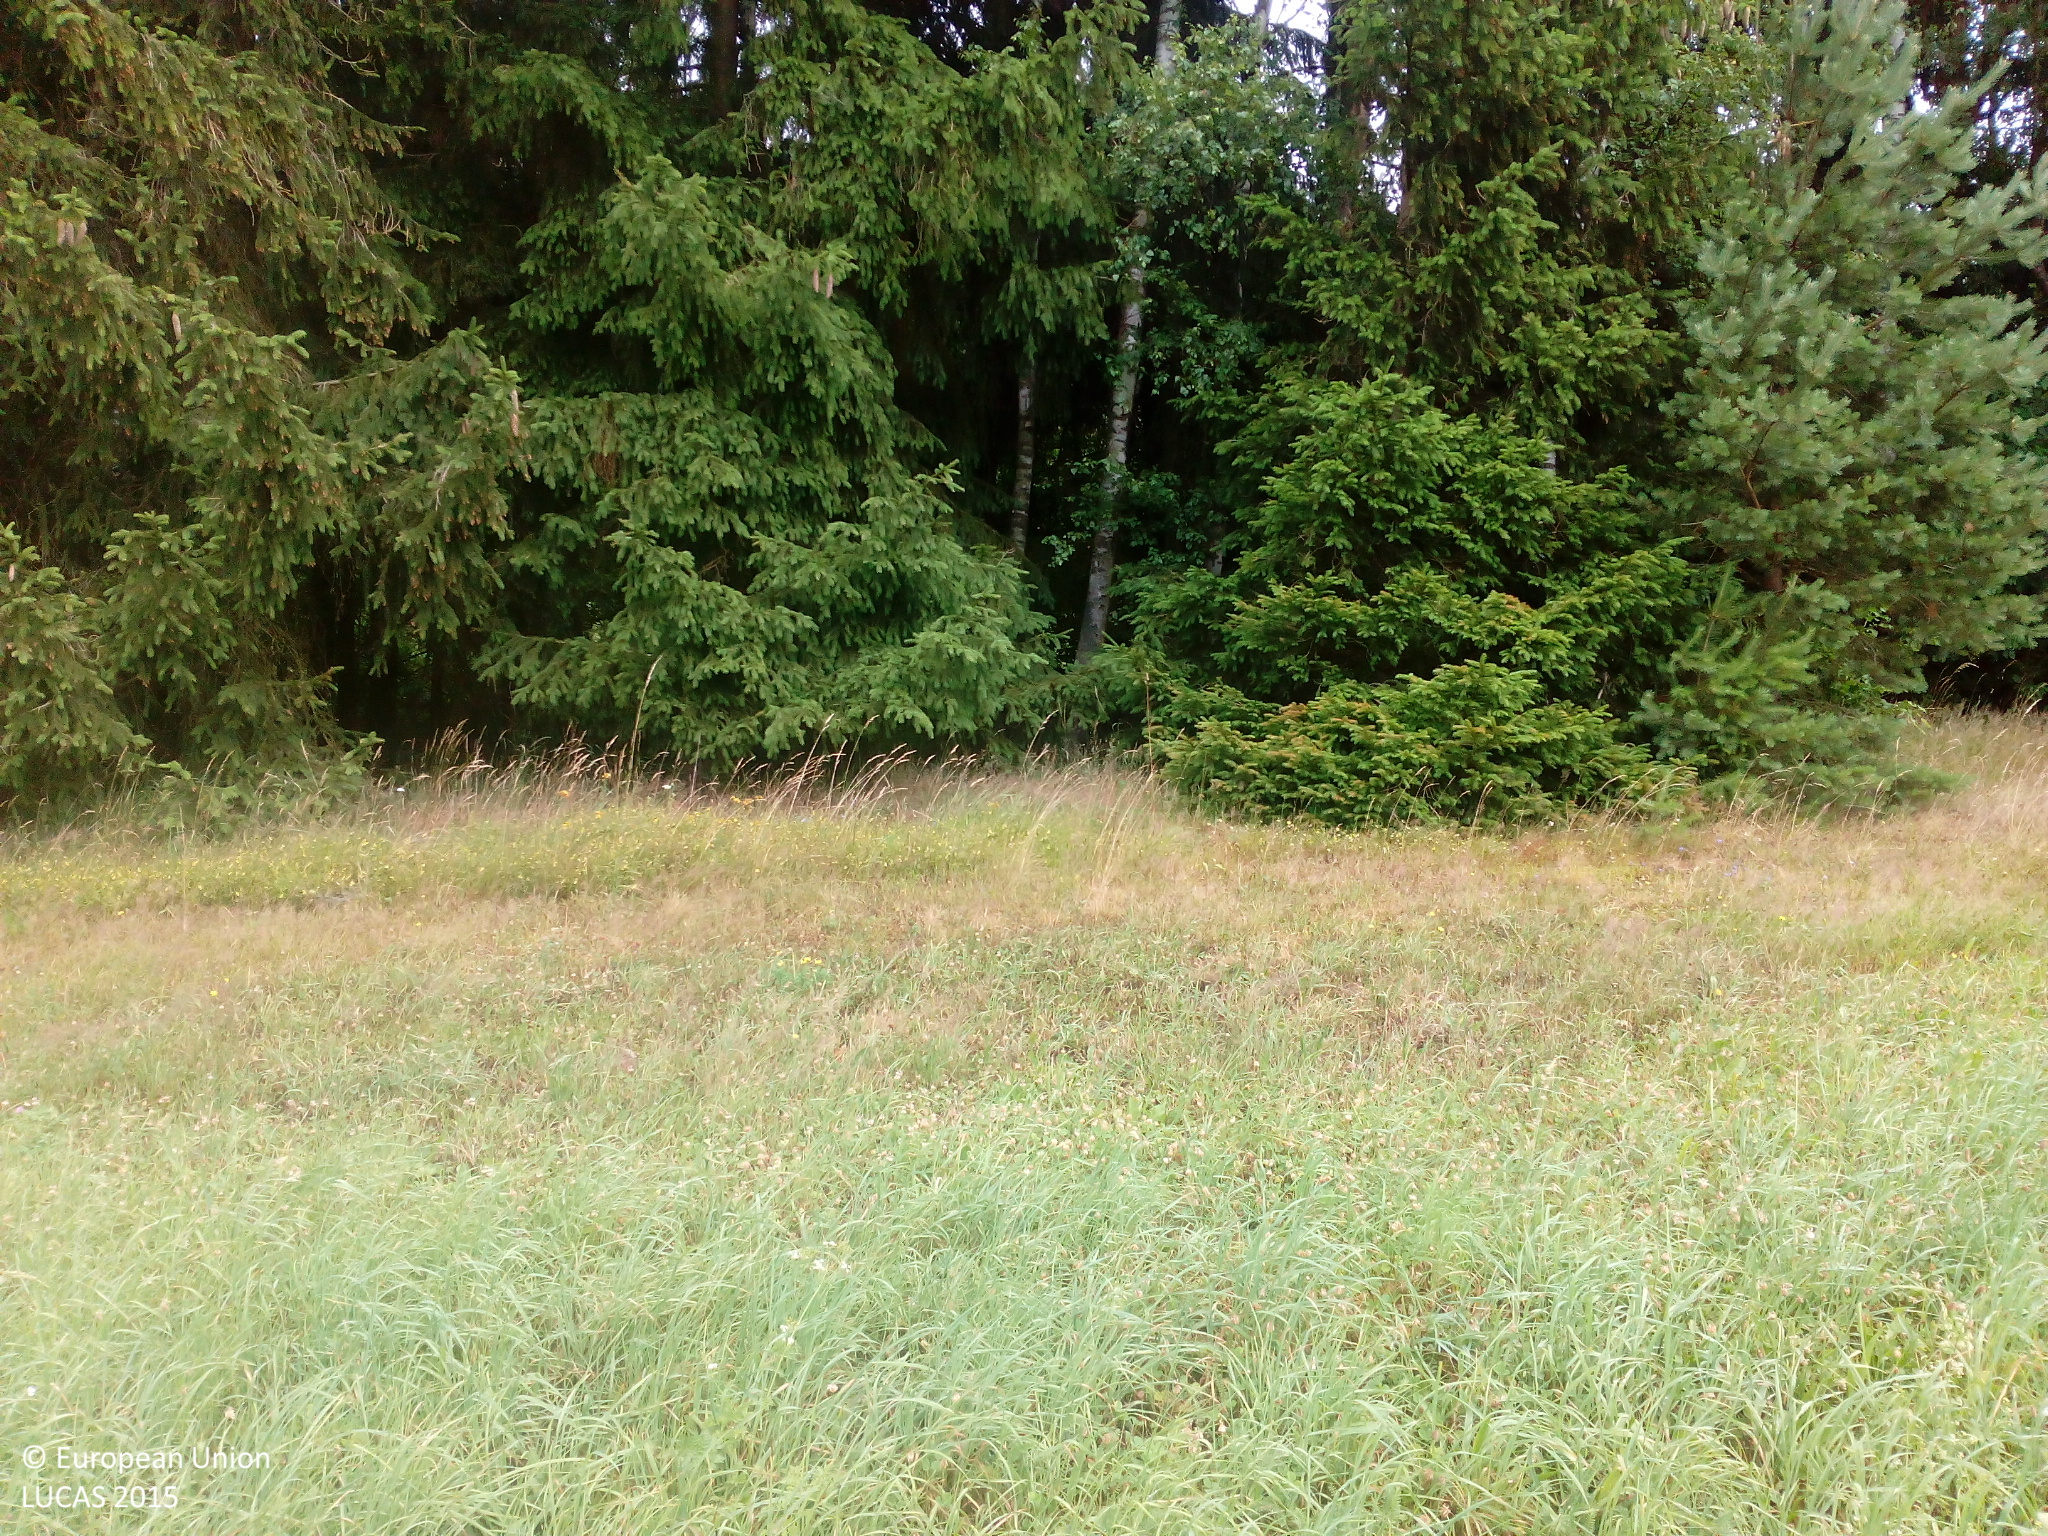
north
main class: Grassland
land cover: Grassland without tree/shrub cover
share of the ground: > 75 %
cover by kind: herbaceous plants 90 %, unconsolidated bare surface 10 %
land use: Agriculture (excluding fallow land and kitchen gardens)
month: July
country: DE
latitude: 49.6541
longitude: 12.4513
